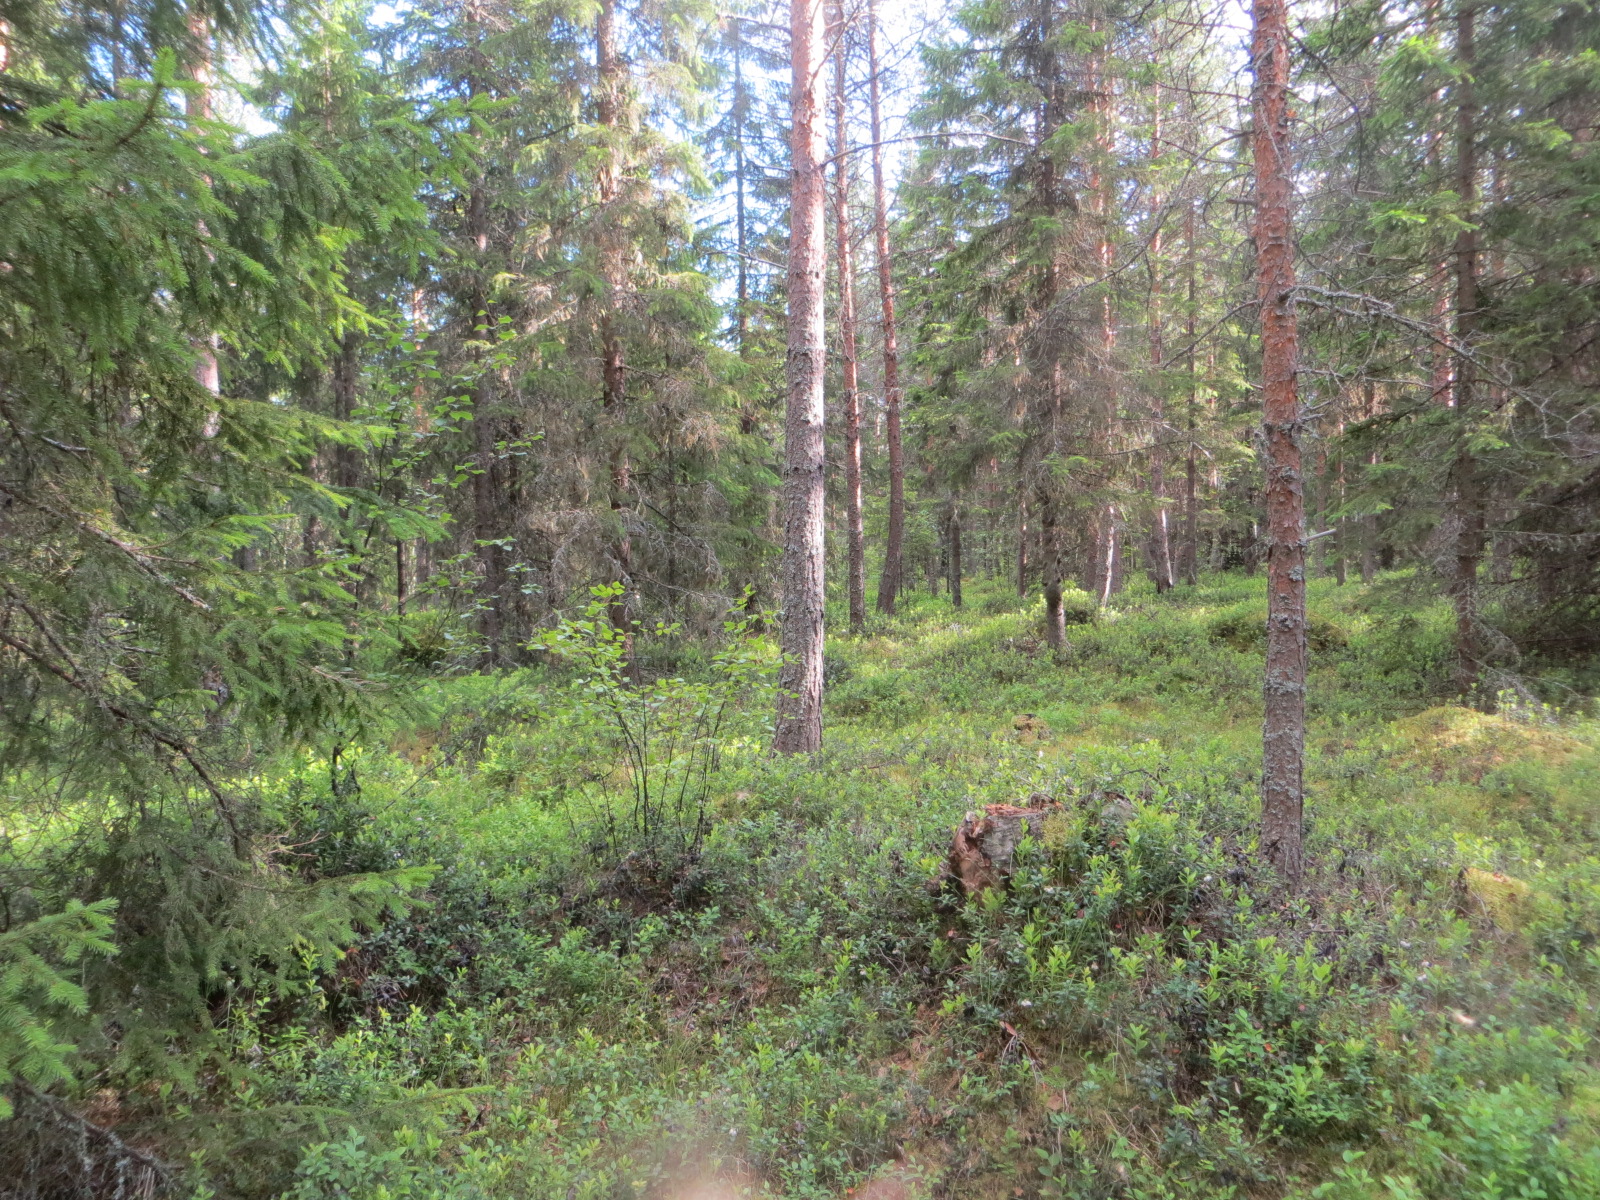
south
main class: Woodland
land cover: Other coniferous woodland
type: boreal forest
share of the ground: 50 - 75 %
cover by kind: coniferous forest trees 60 %, shrubs 40 %
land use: Forestry
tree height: > 5 m
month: July
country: FI
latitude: 65.4549
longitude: 25.3712
